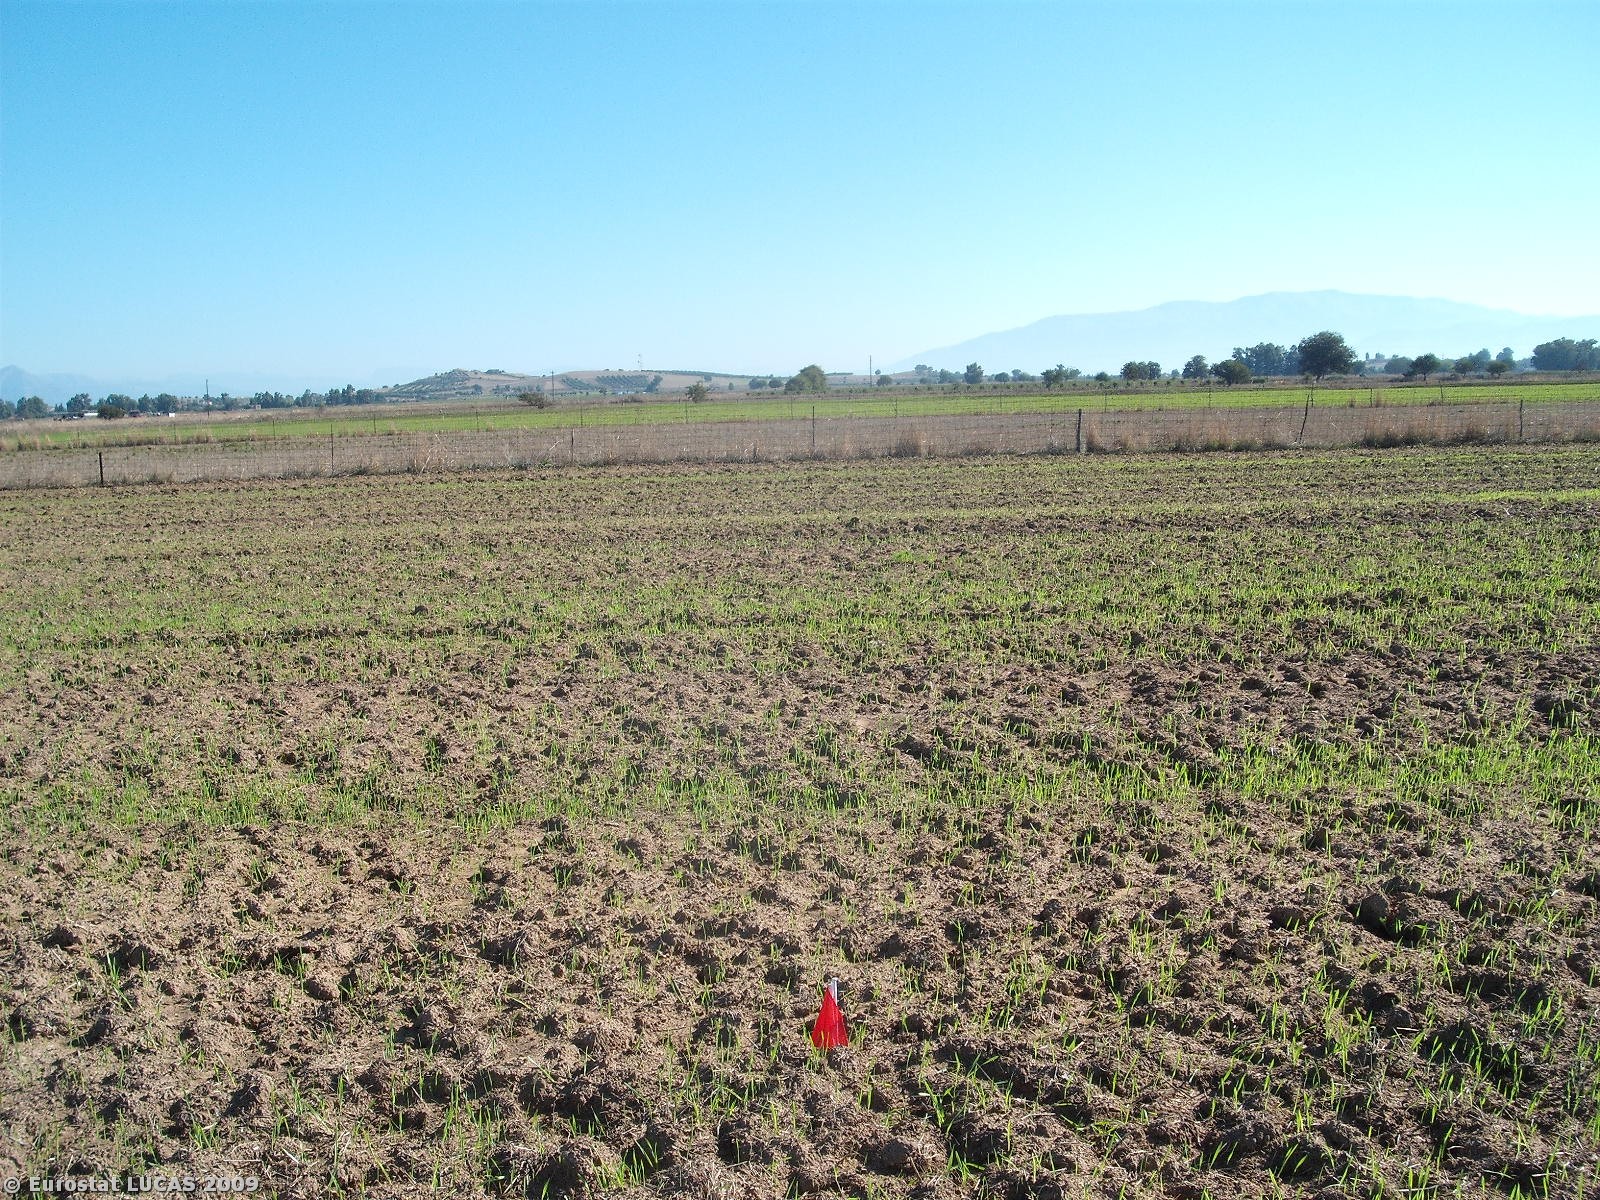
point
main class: Cropland
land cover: Mixed cereals for fodder
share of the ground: < 10 %
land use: Agriculture (excluding fallow land and kitchen gardens)
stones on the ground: < 10 %
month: October
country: GR
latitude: 38.1505
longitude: 21.4559
